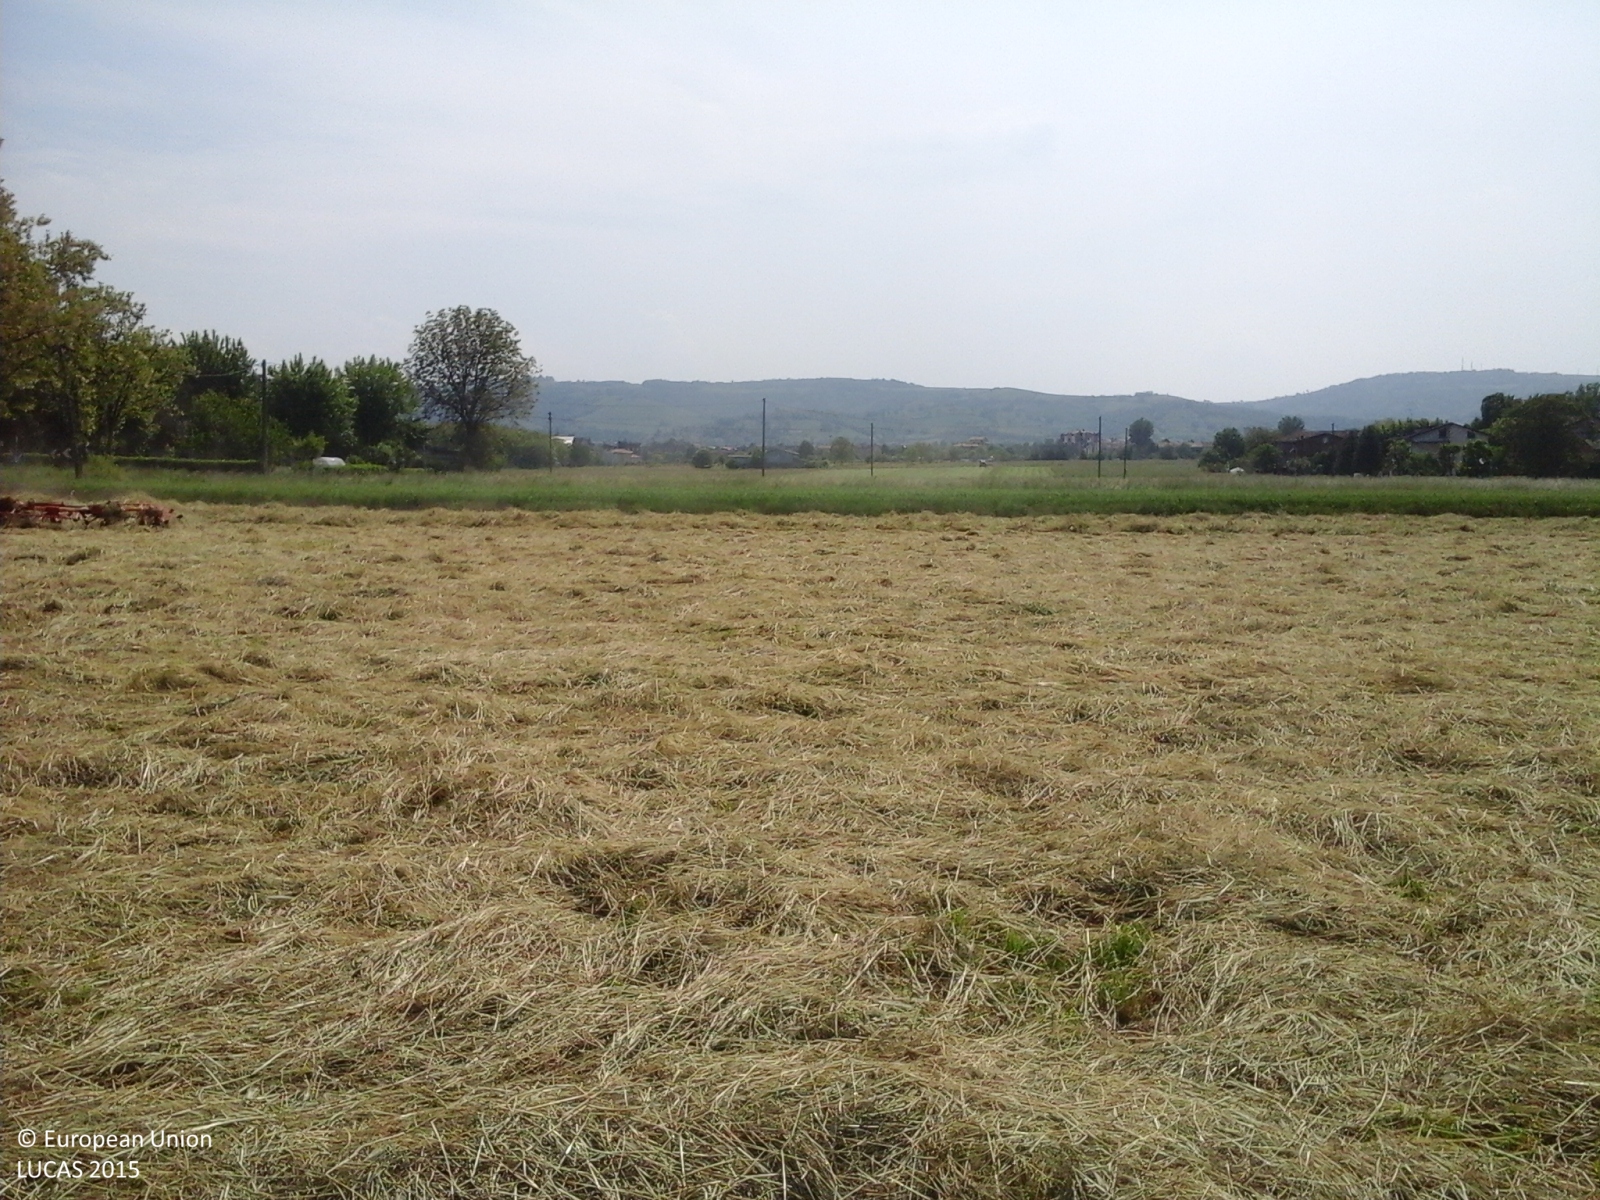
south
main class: Grassland
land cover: Spontaneously vegetated surfaces
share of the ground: > 75 %
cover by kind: herbaceous plants 100 %
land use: Agriculture (excluding fallow land and kitchen gardens)
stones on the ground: < 10 %
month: May
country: IT
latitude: 44.6004
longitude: 10.7417
